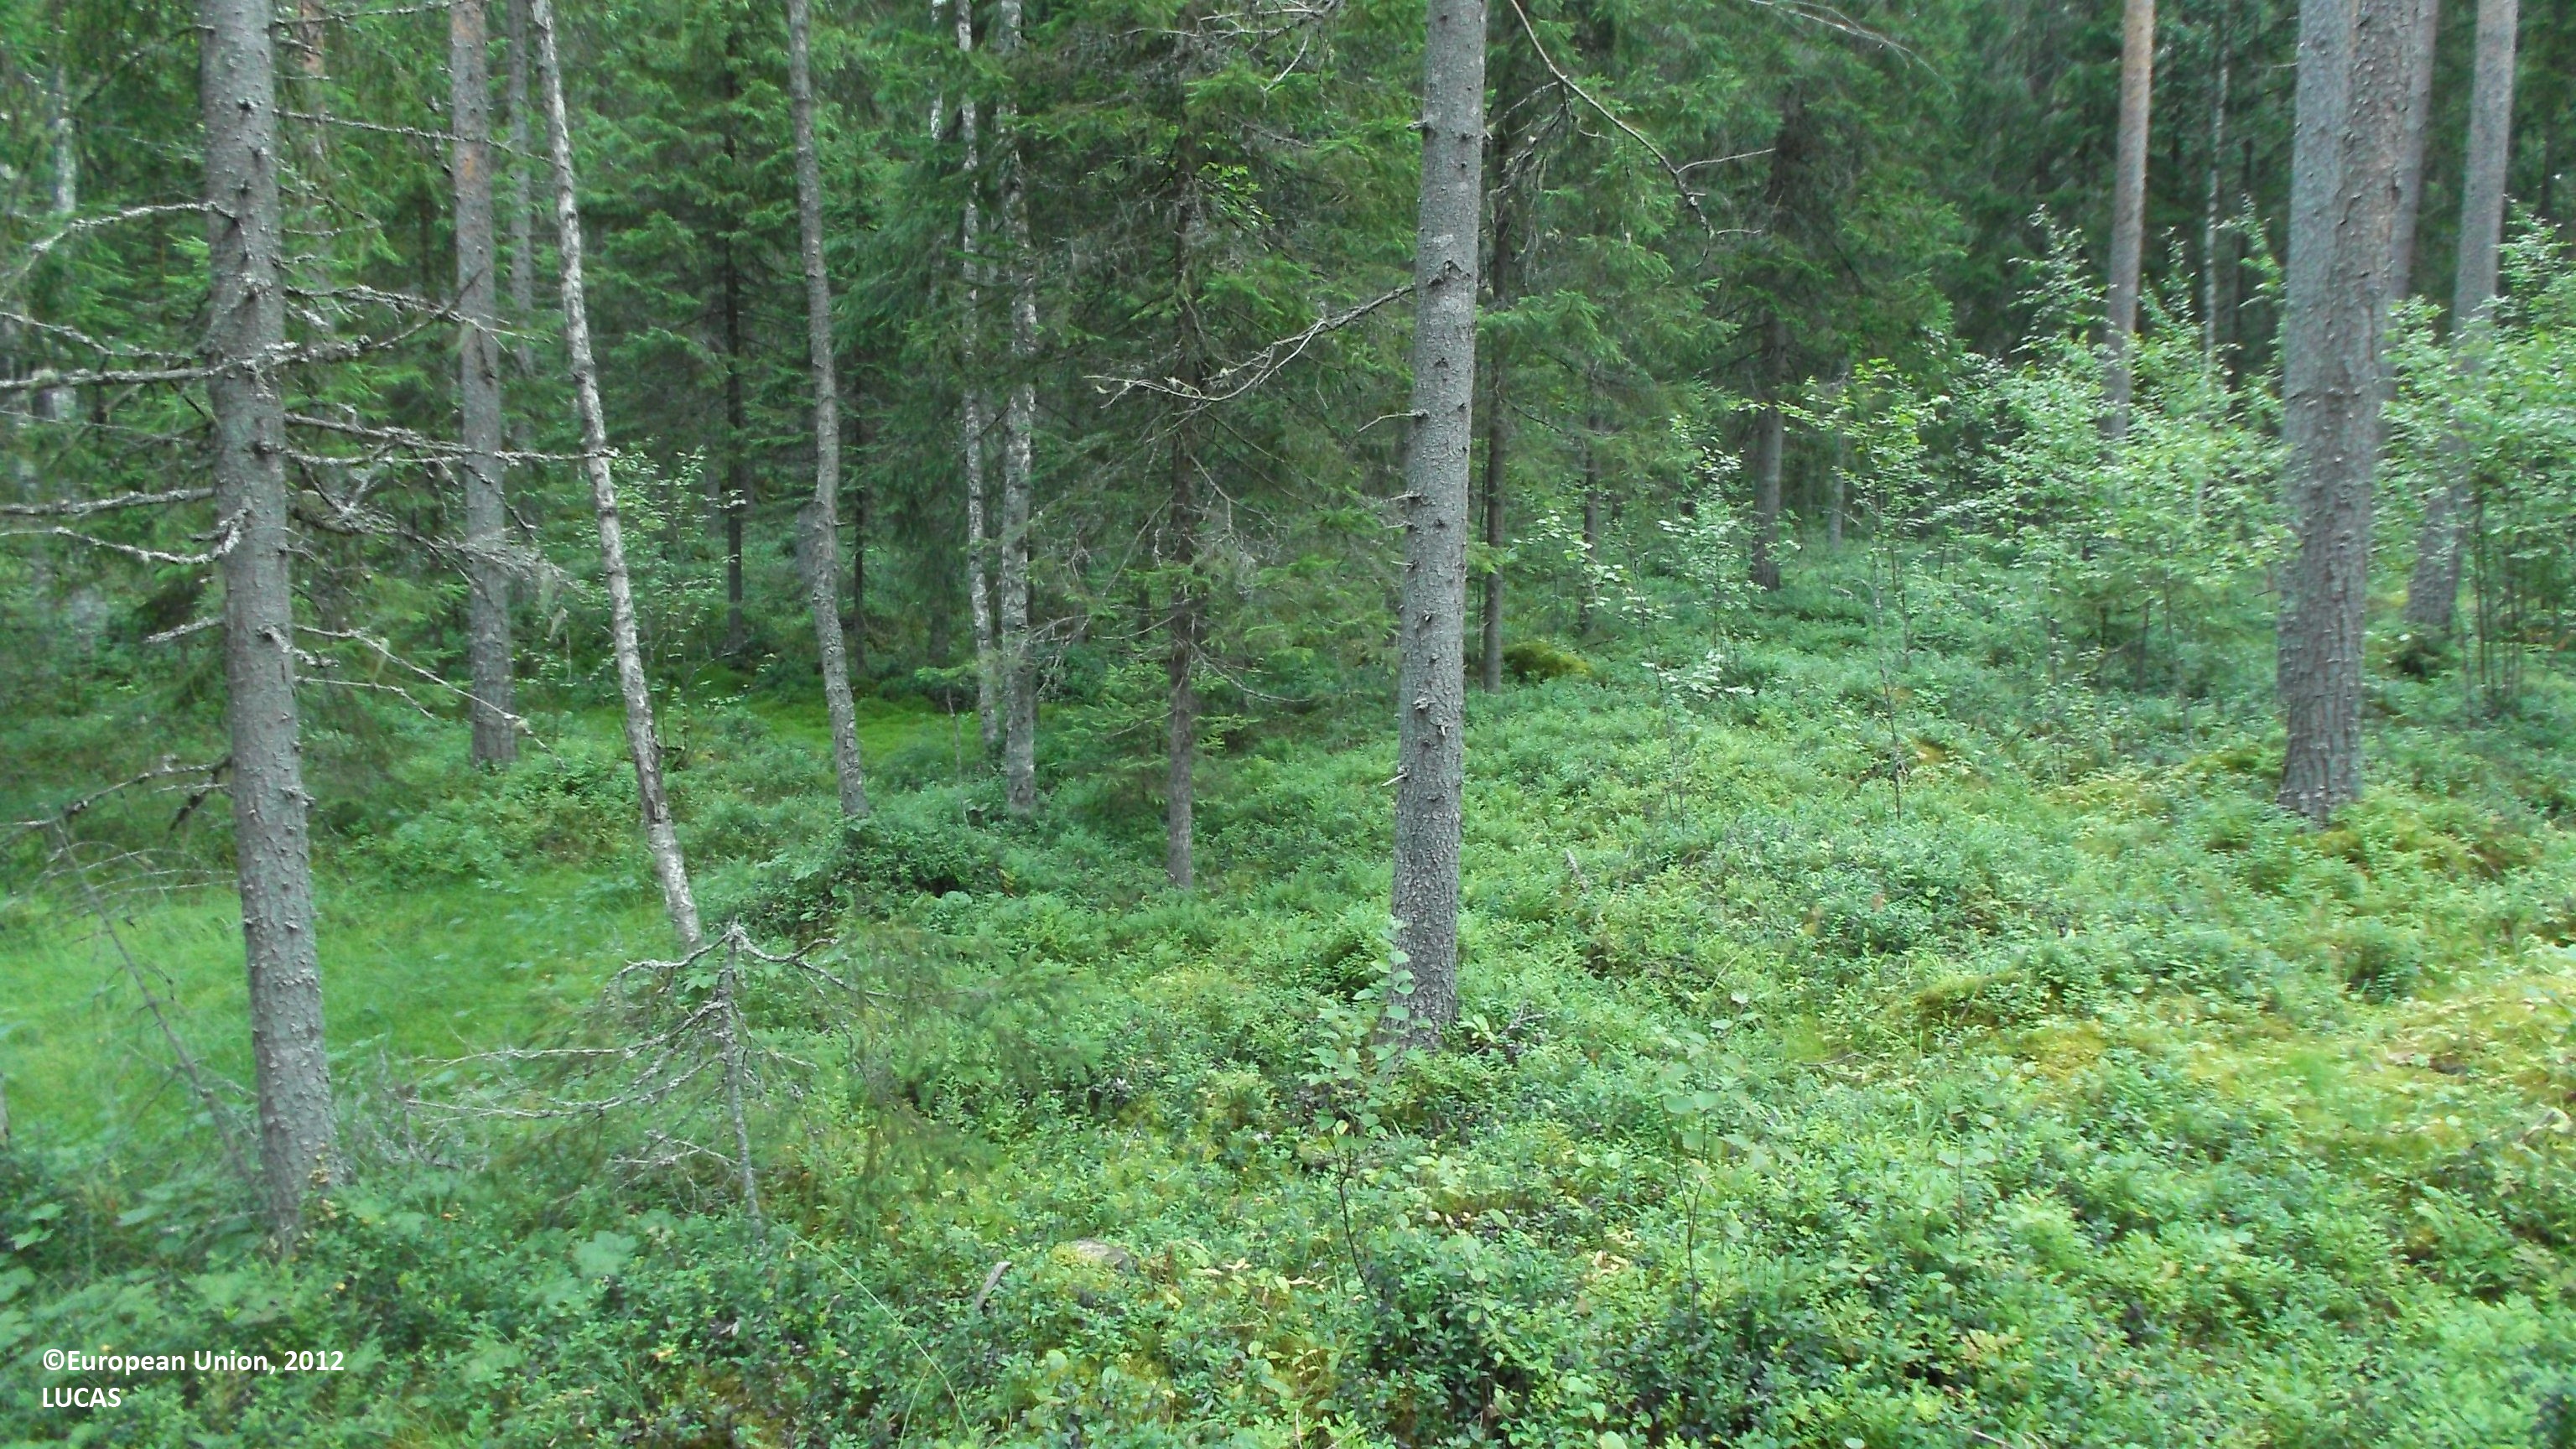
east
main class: Woodland
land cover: Other mixed woodland
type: boreal forest
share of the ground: 25 - 50 %
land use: Forestry
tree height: > 5 m
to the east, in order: Other mixed woodland; Spruce dominated mixed woodland; Spruce dominated coniferous woodland; Spruce dominated mixed woodland; Spruce dominated coniferous woodland; Ditches and canals; Temporary grasslands; Ditches and canals; Temporary grasslands; Ditches and canals; Temporary grasslands; Ditches and canals; Pine dominated mixed woodland
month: August
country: FI
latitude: 63.9285
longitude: 23.4972
